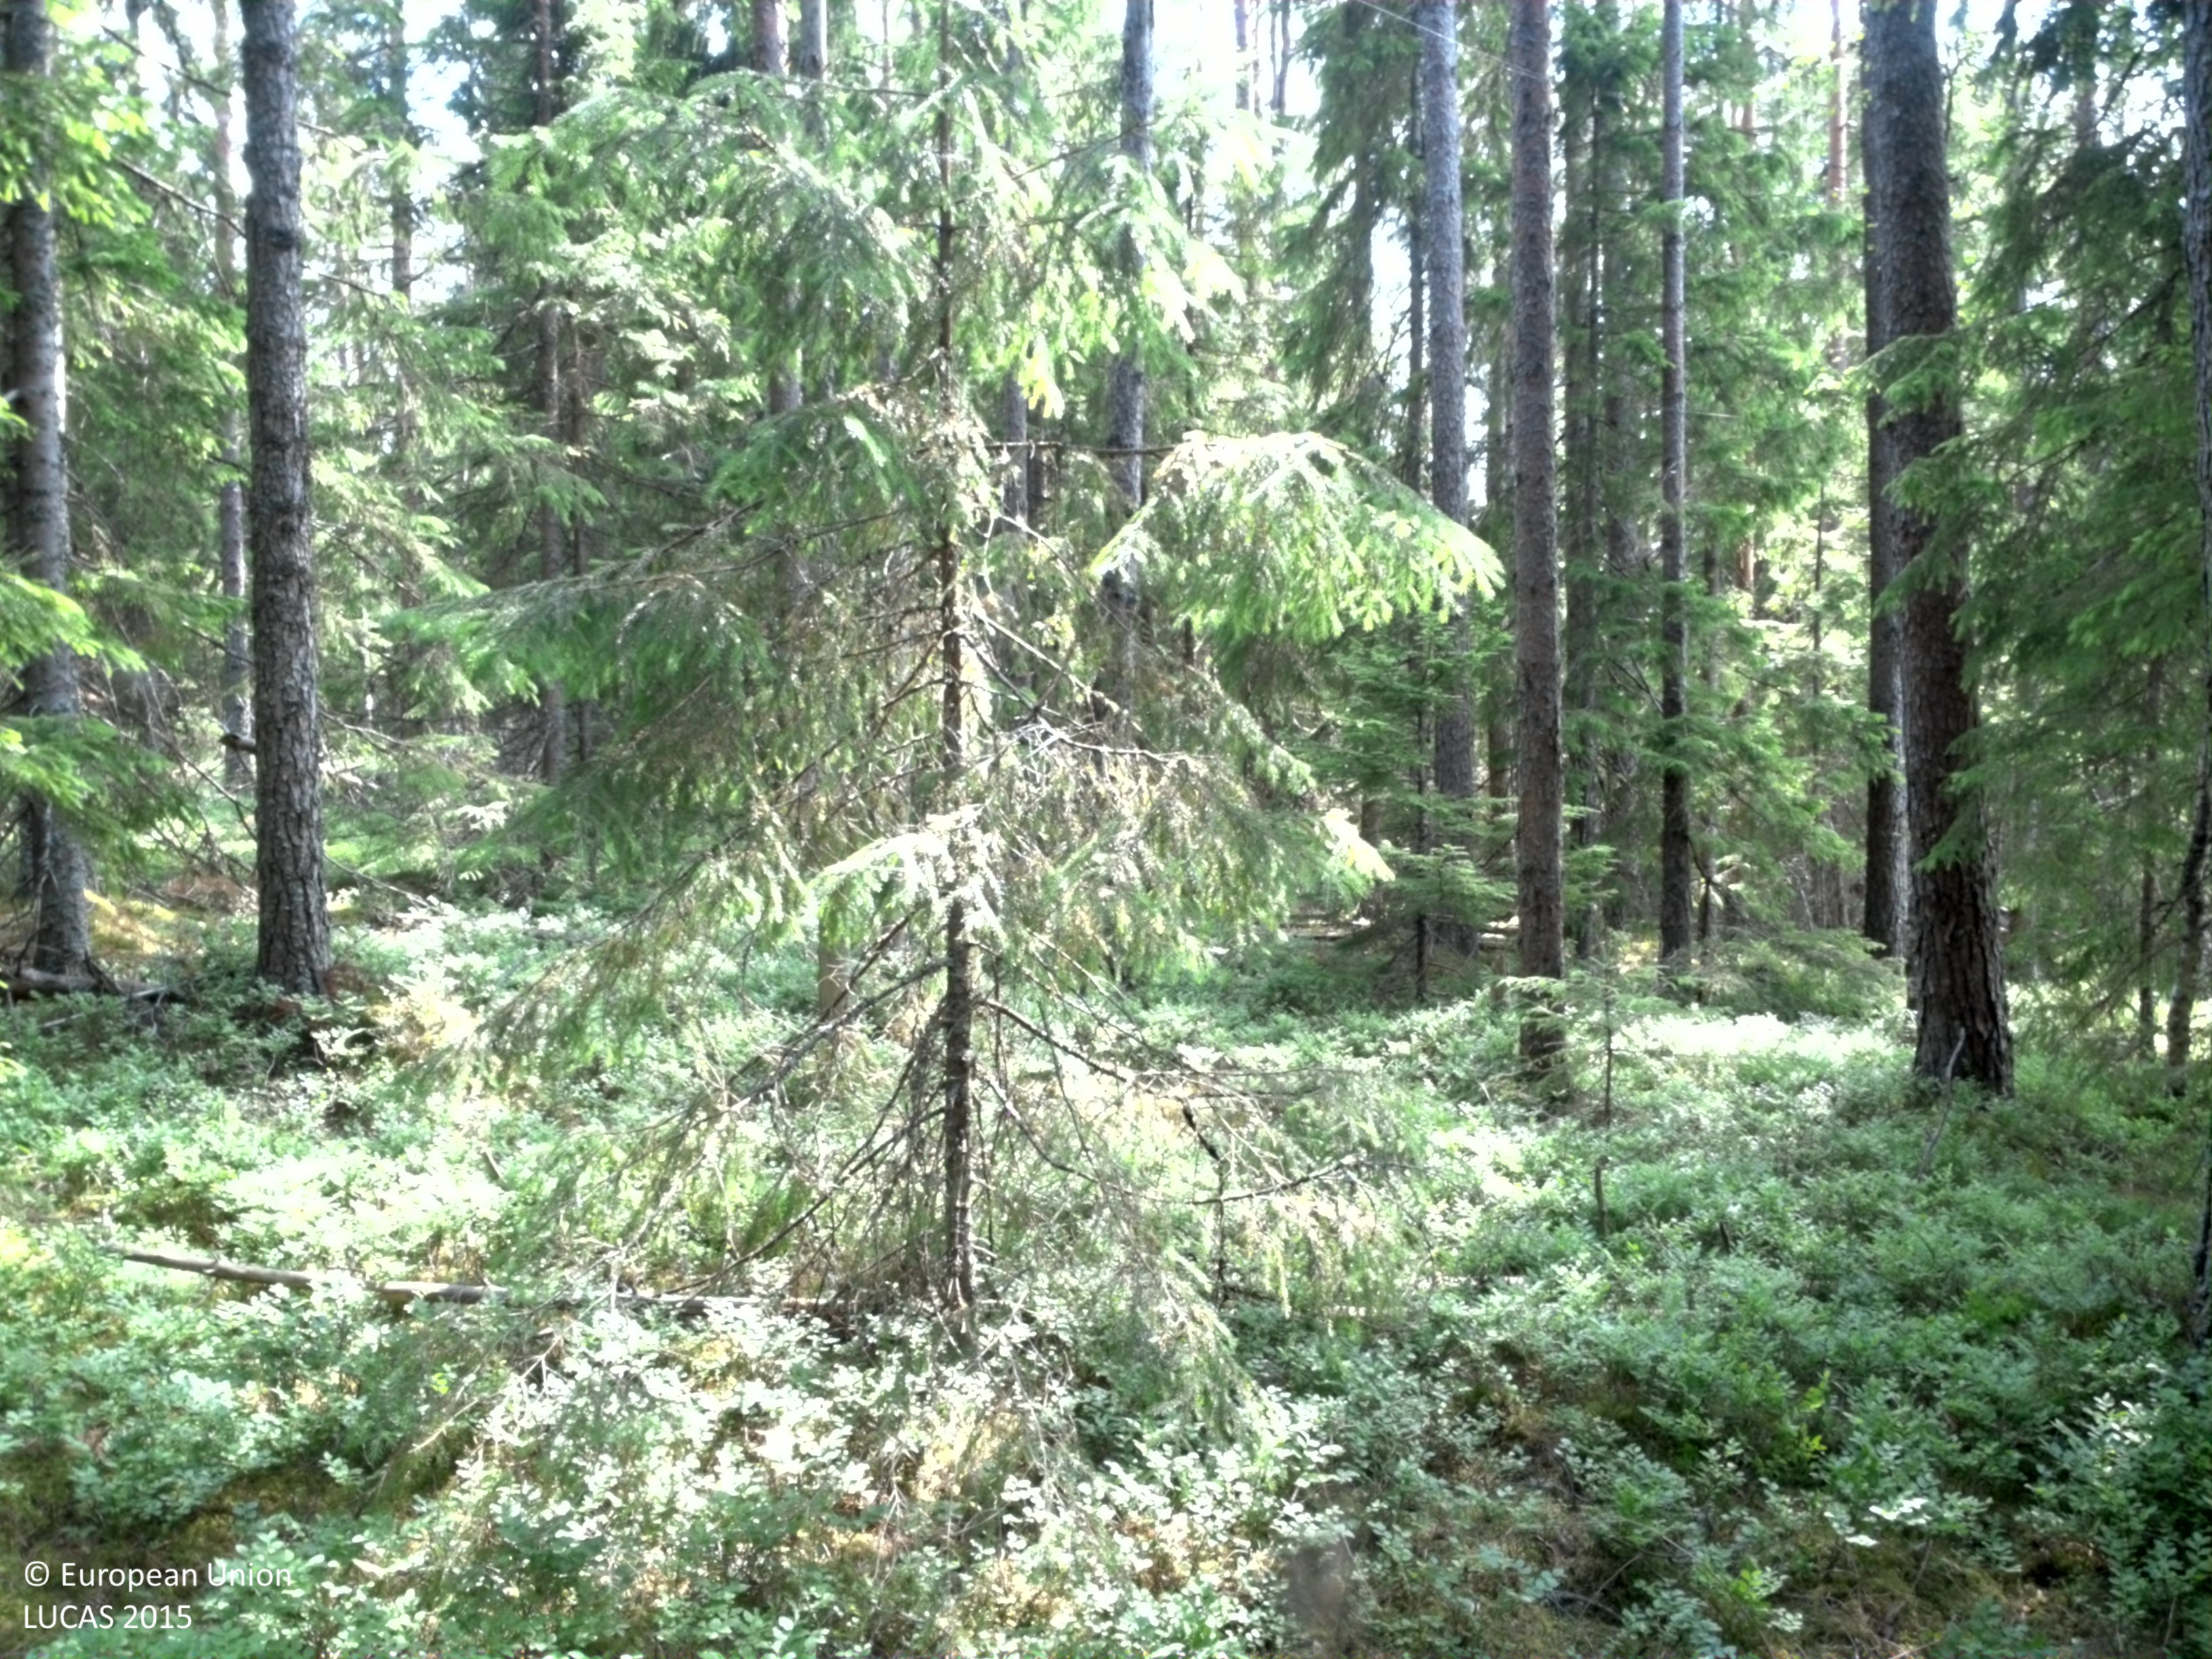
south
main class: Woodland
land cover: Pine dominated coniferous woodland
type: boreal forest
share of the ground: 50 - 75 %
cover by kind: coniferous forest trees 75 %, lichens and mosses 20 %, shrubs 5 %
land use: Forestry
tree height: > 5 m
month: July
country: SE
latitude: 57.6578
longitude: 13.9337
